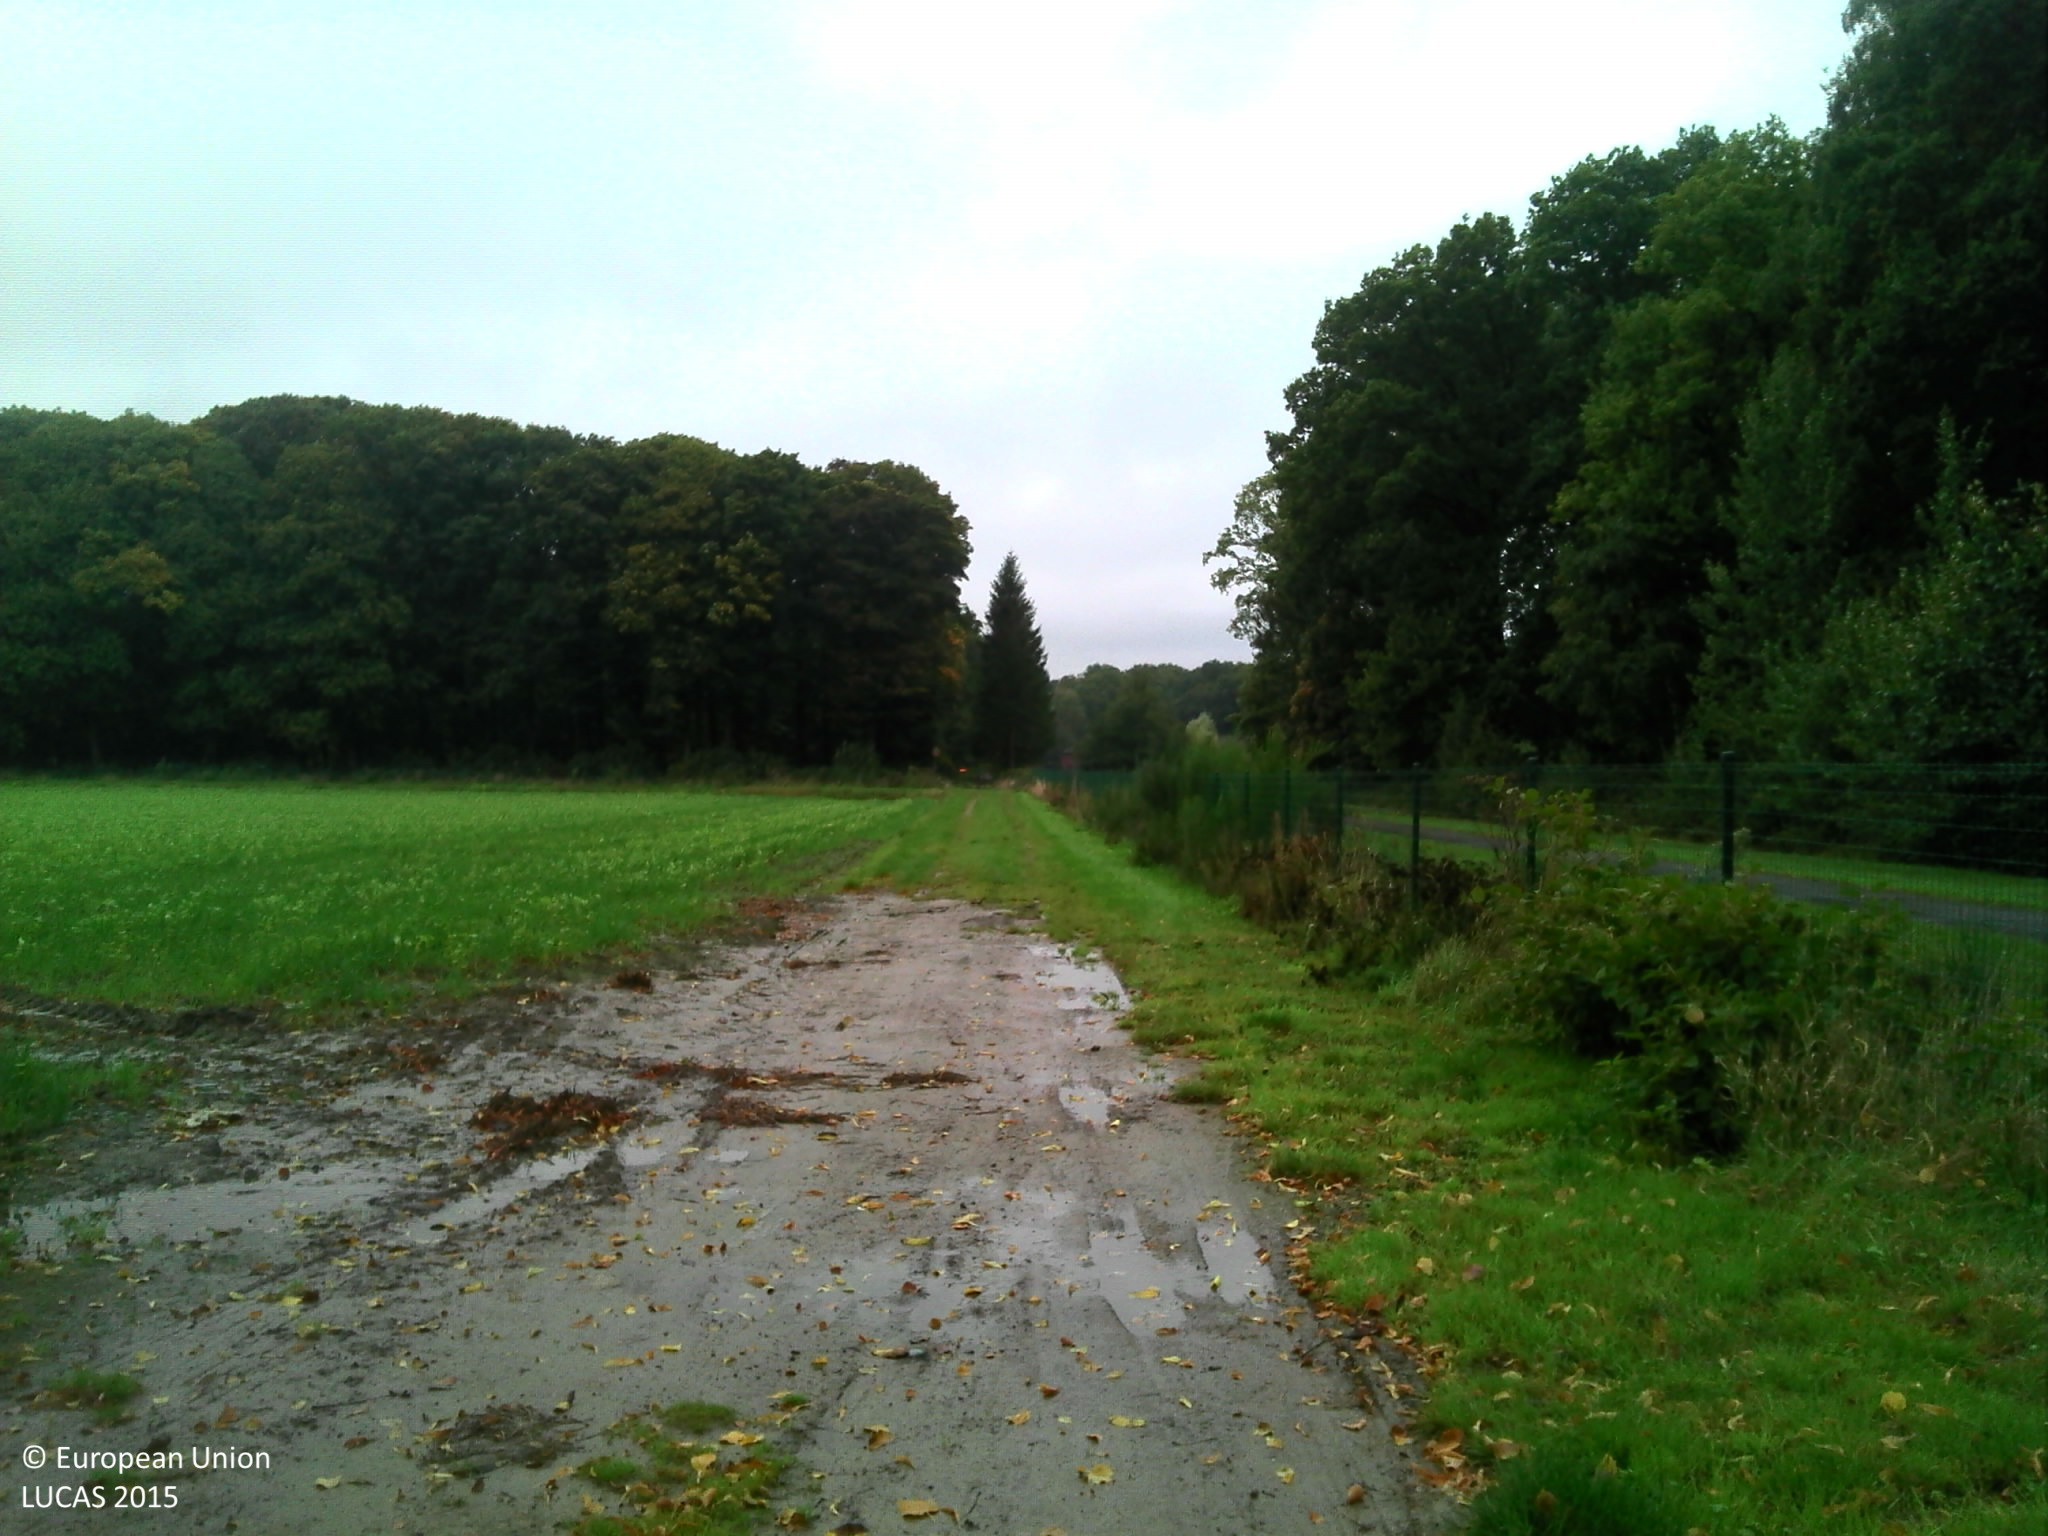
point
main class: Cropland
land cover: Other fibre and oleaginous crops
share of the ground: 50 - 75 %
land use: Agriculture (excluding fallow land and kitchen gardens)
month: October
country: BE
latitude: 50.9599
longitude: 2.9707
